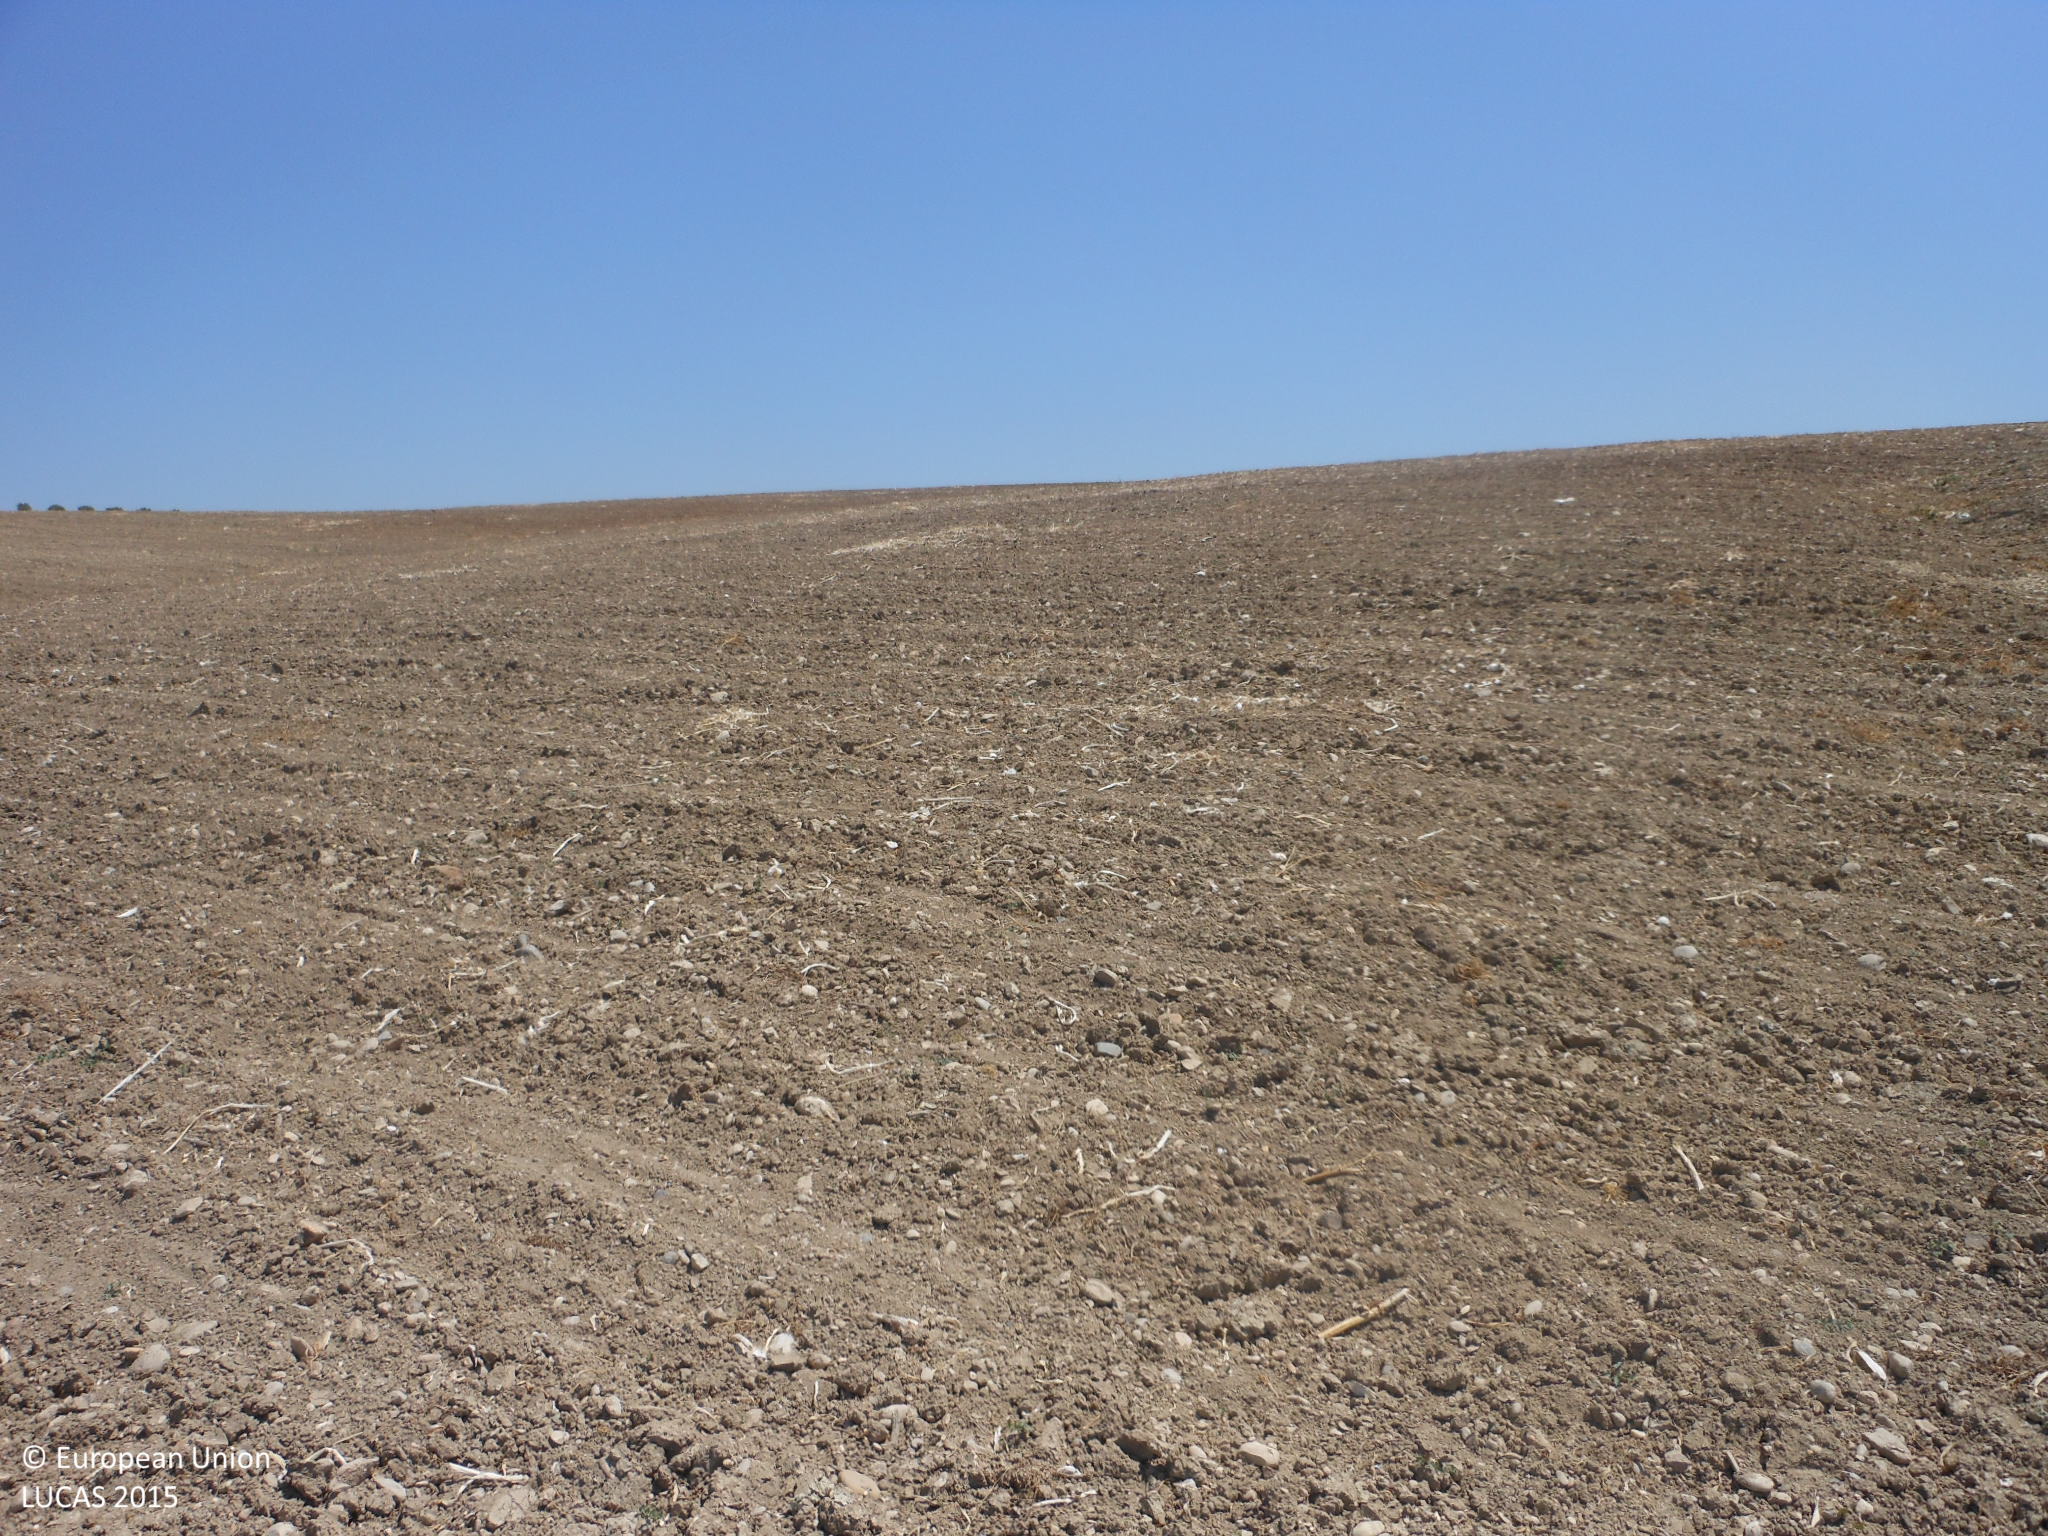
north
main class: Cropland
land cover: Other root crops
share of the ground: < 10 %
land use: Agriculture (excluding fallow land and kitchen gardens)
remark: Harvested field
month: June
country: ES
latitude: 37.4184
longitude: -4.8661
